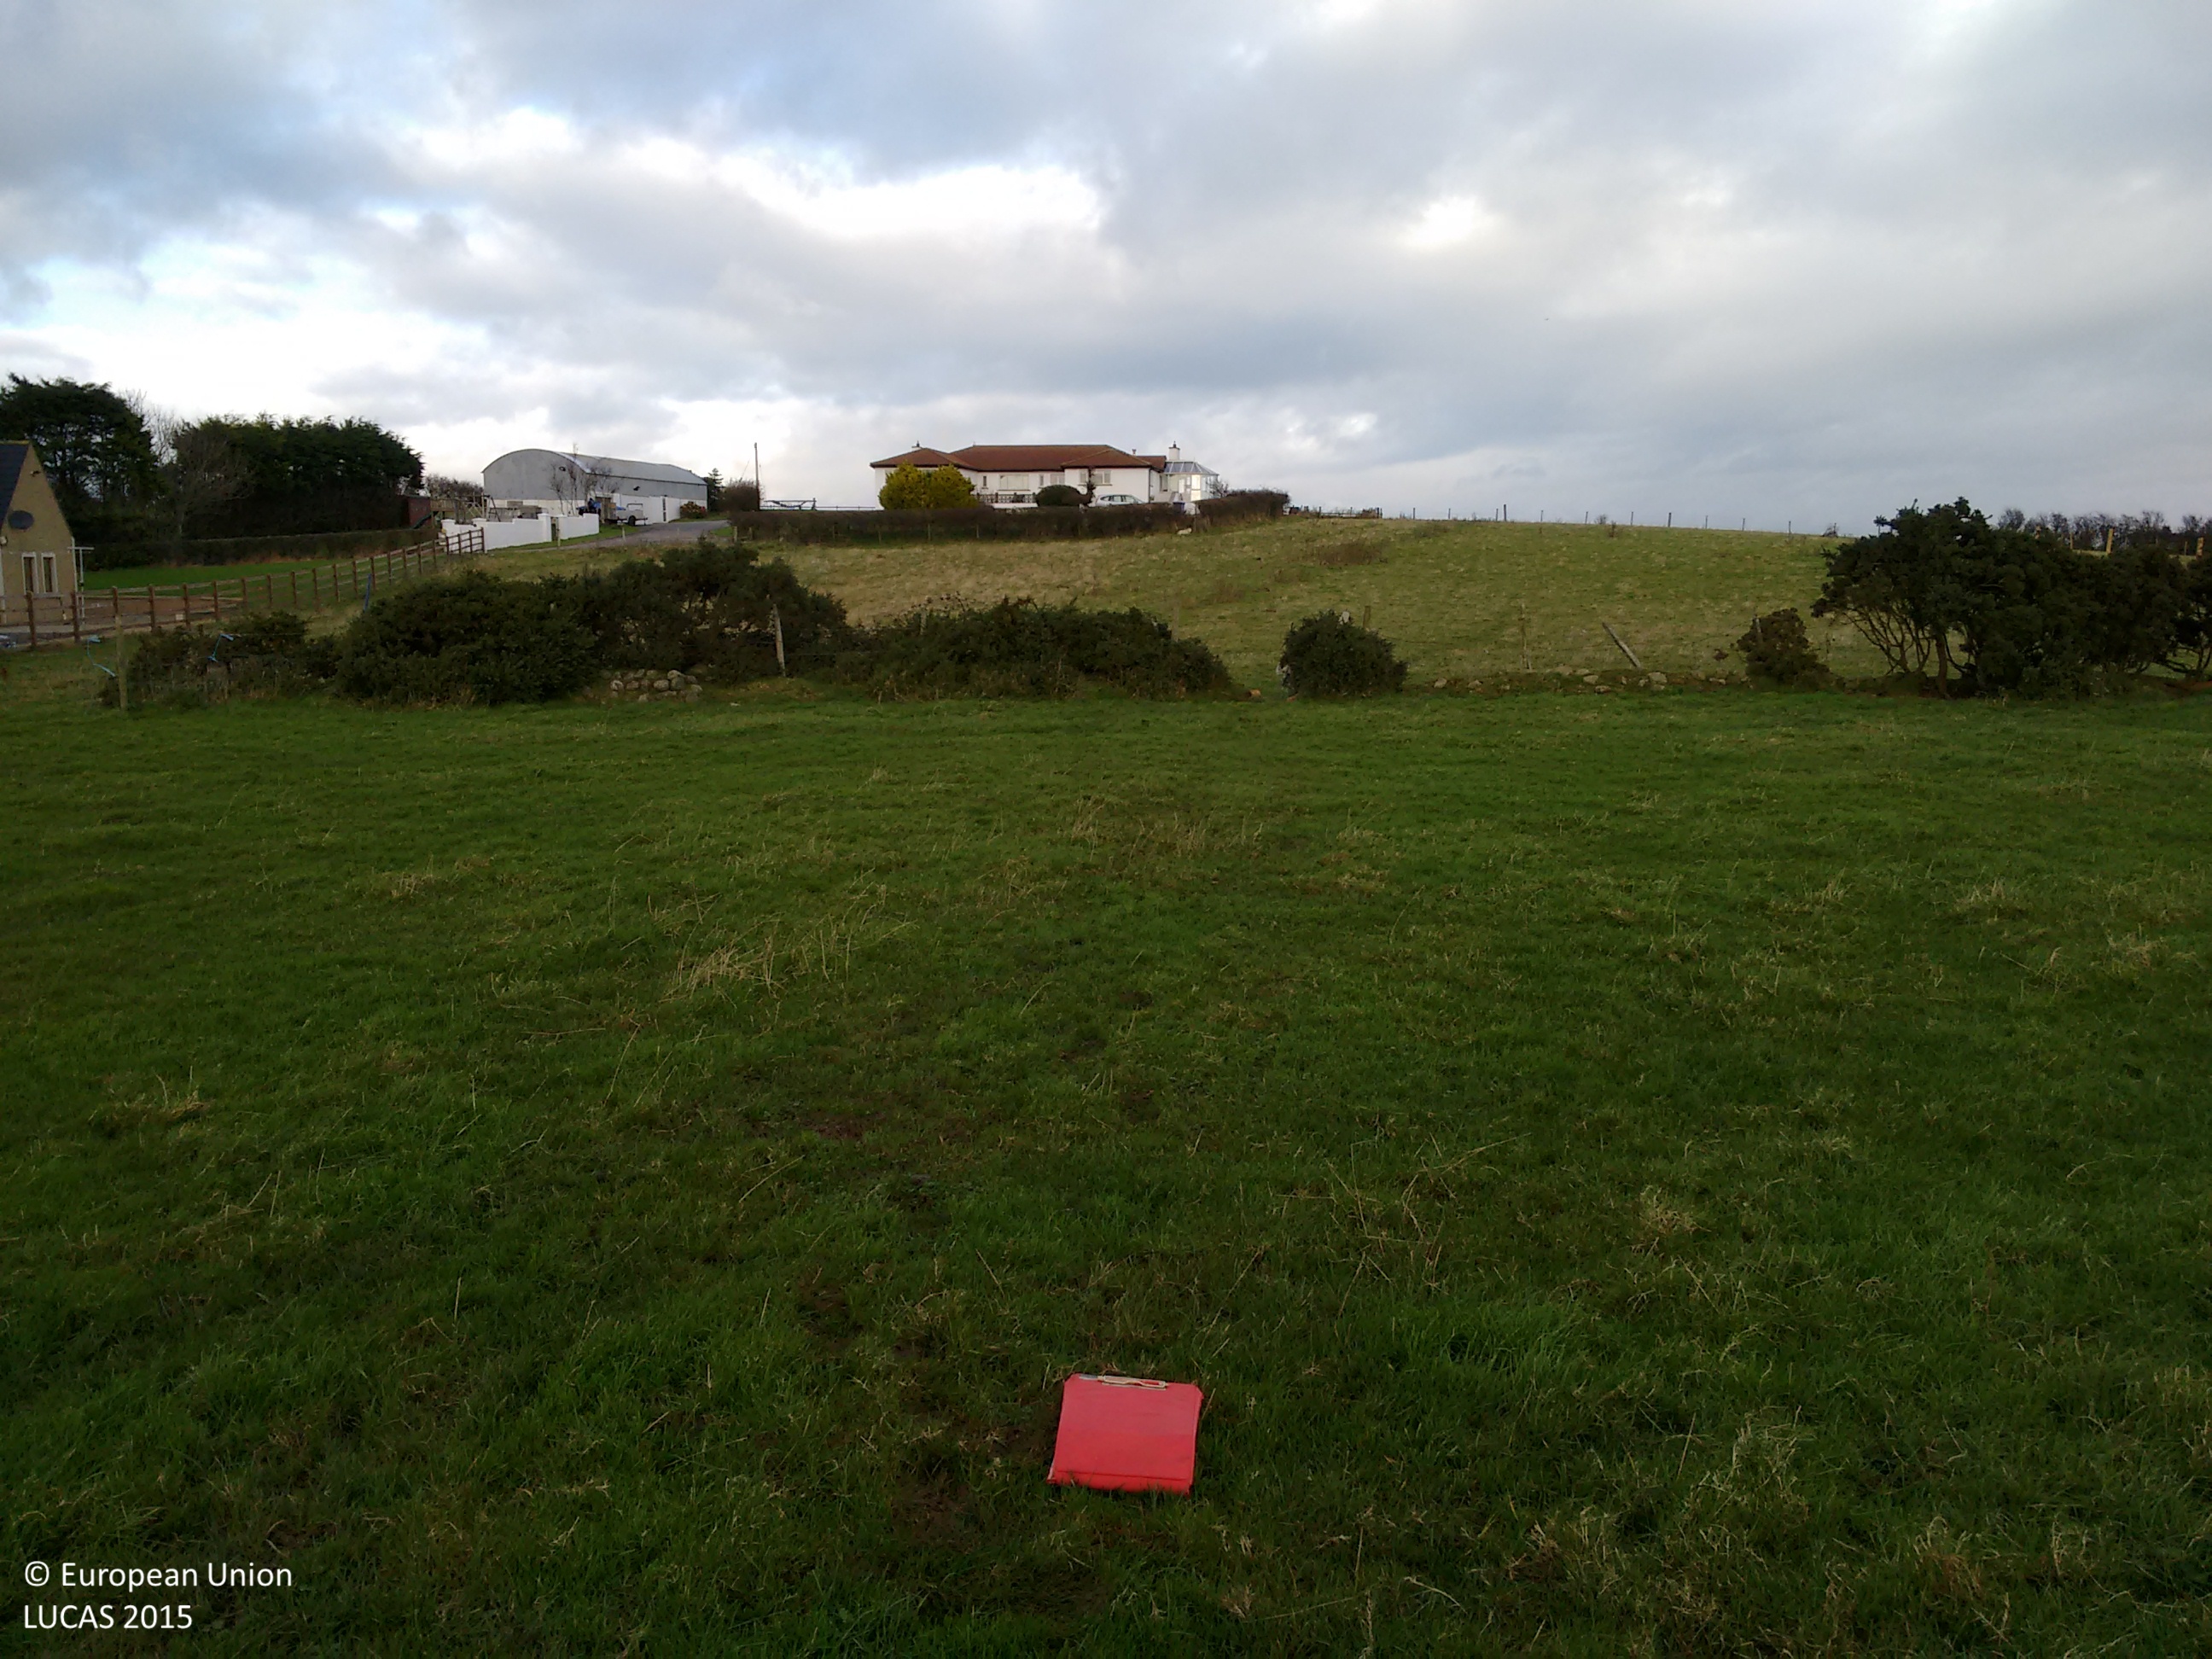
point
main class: Grassland
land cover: Grassland without tree/shrub cover
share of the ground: > 75 %
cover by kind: herbaceous plants 100 %
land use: Agriculture (excluding fallow land and kitchen gardens)
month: November
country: GB
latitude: 54.4908
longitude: -5.4561
